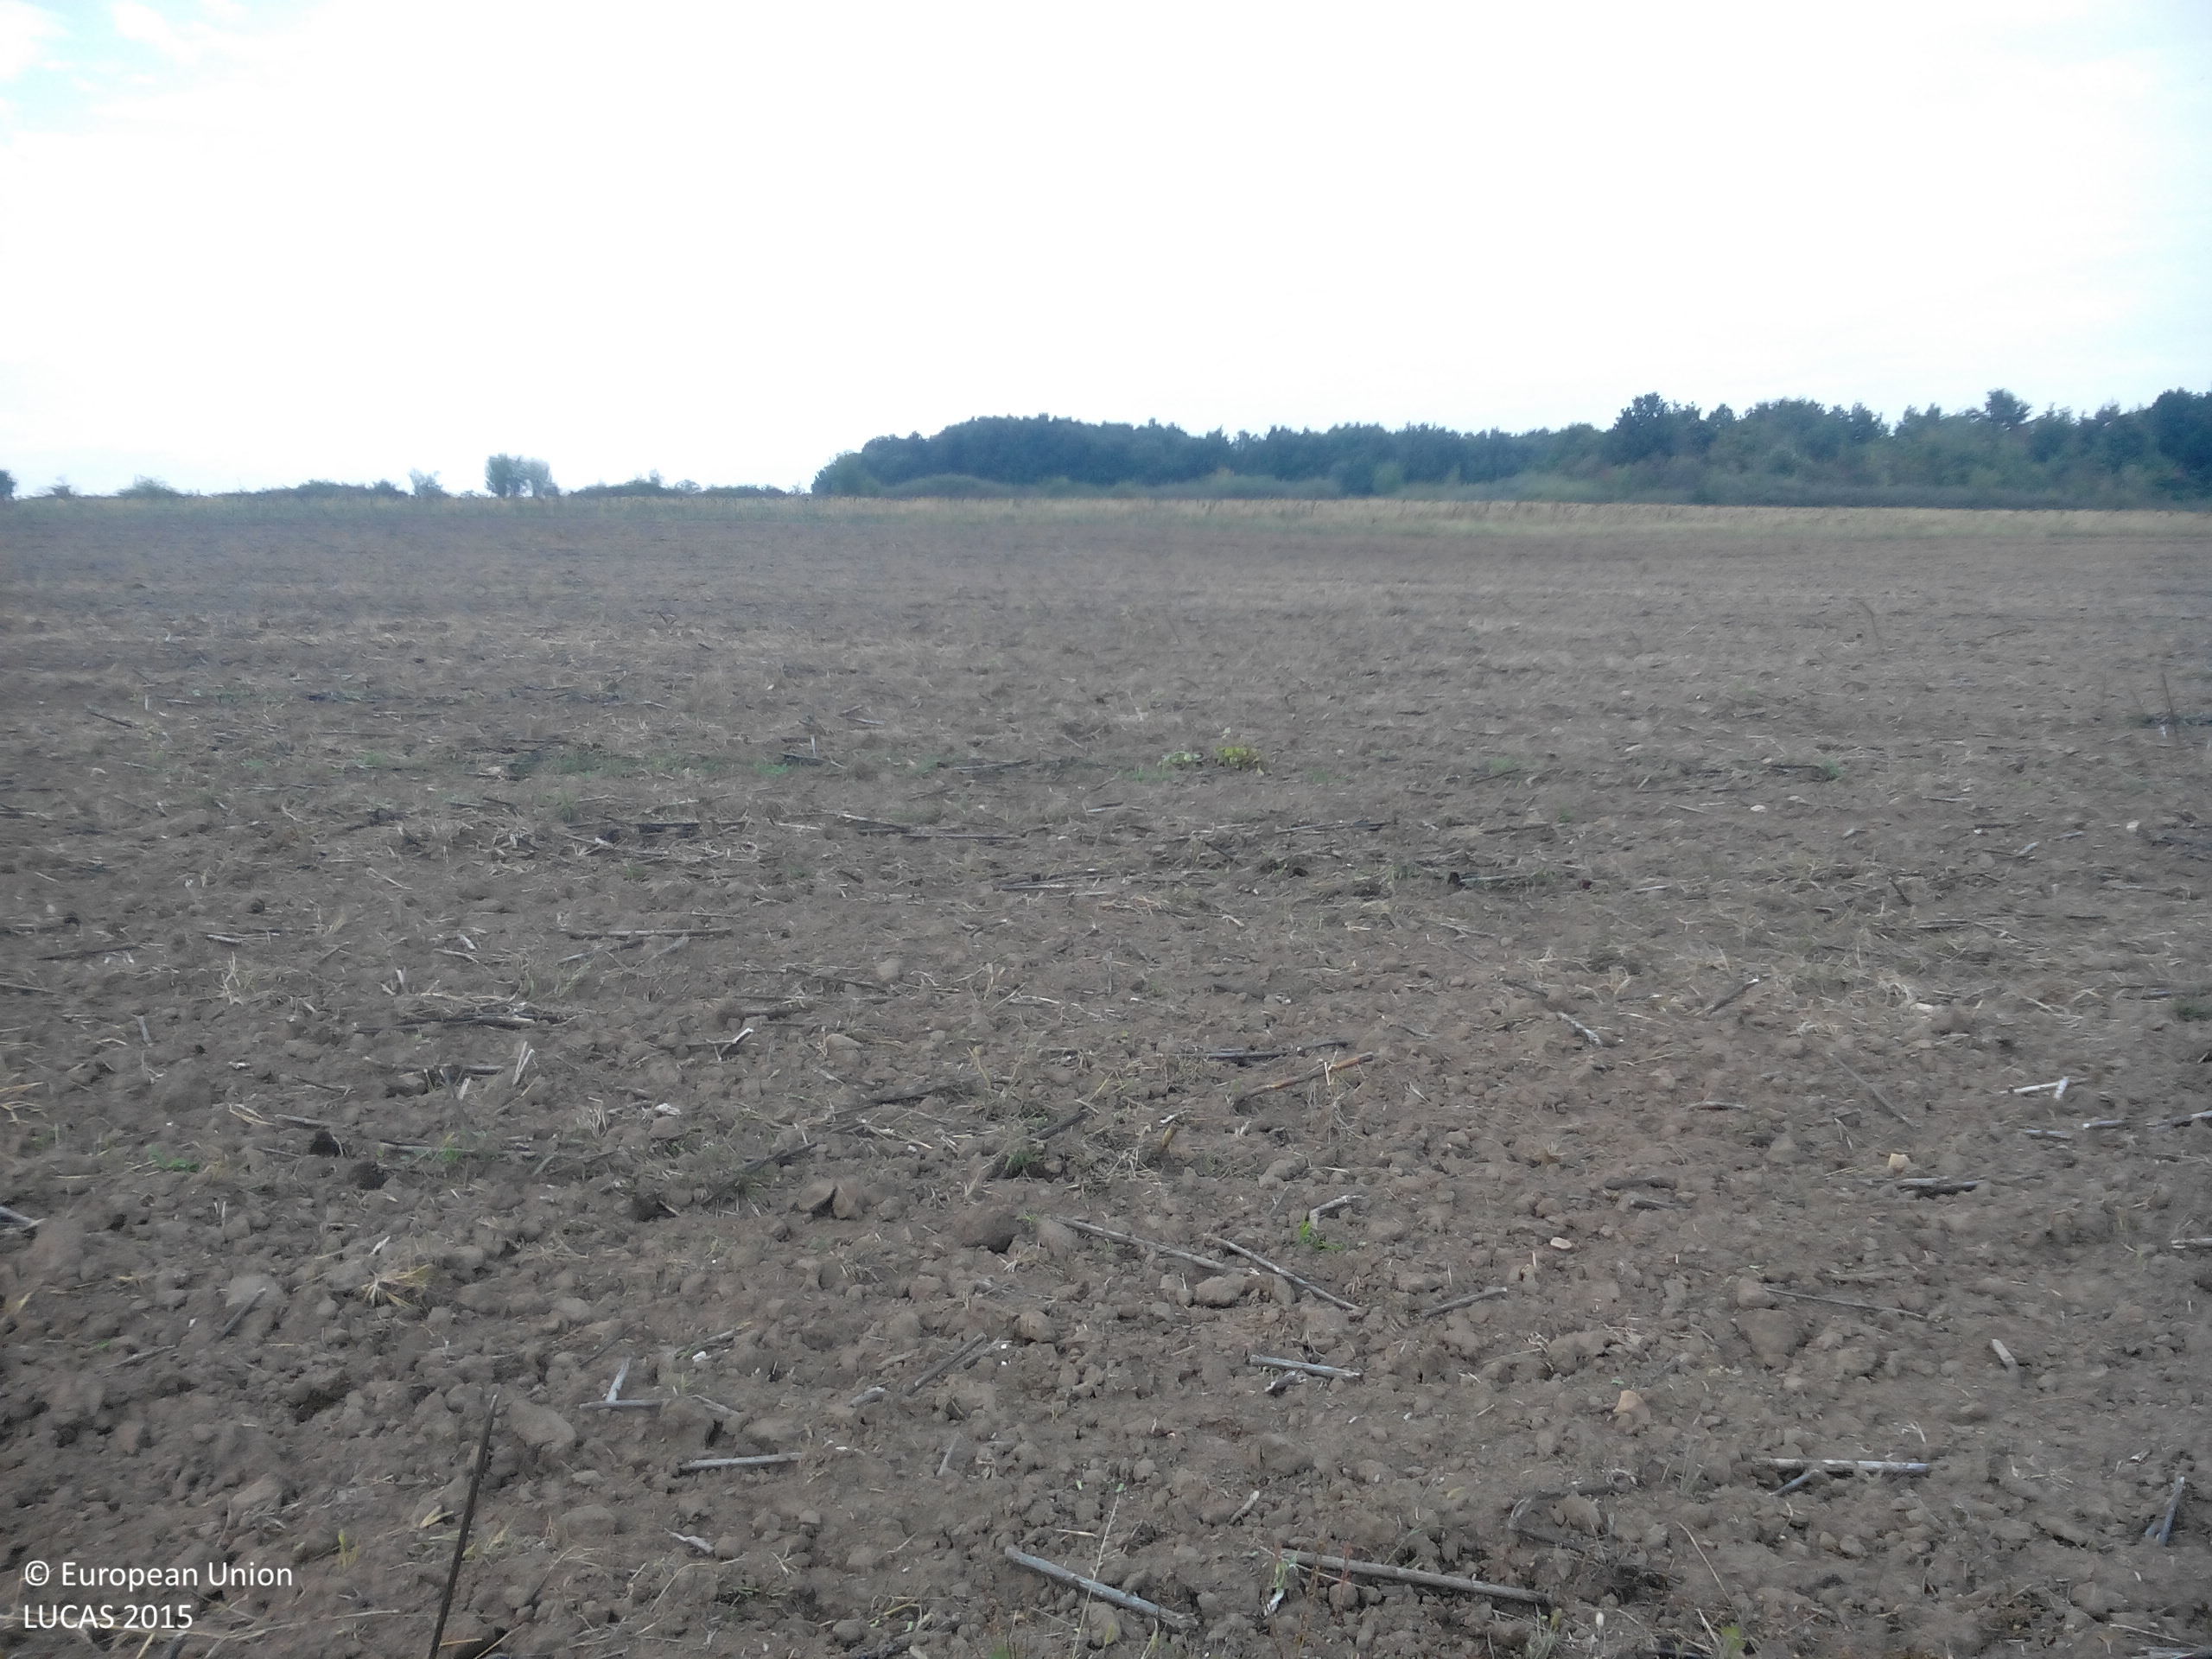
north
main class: Cropland
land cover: Sunflower
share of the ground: < 10 %
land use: Agriculture (excluding fallow land and kitchen gardens)
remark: Harvested field
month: October
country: BG
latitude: 43.3019
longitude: 23.6169
